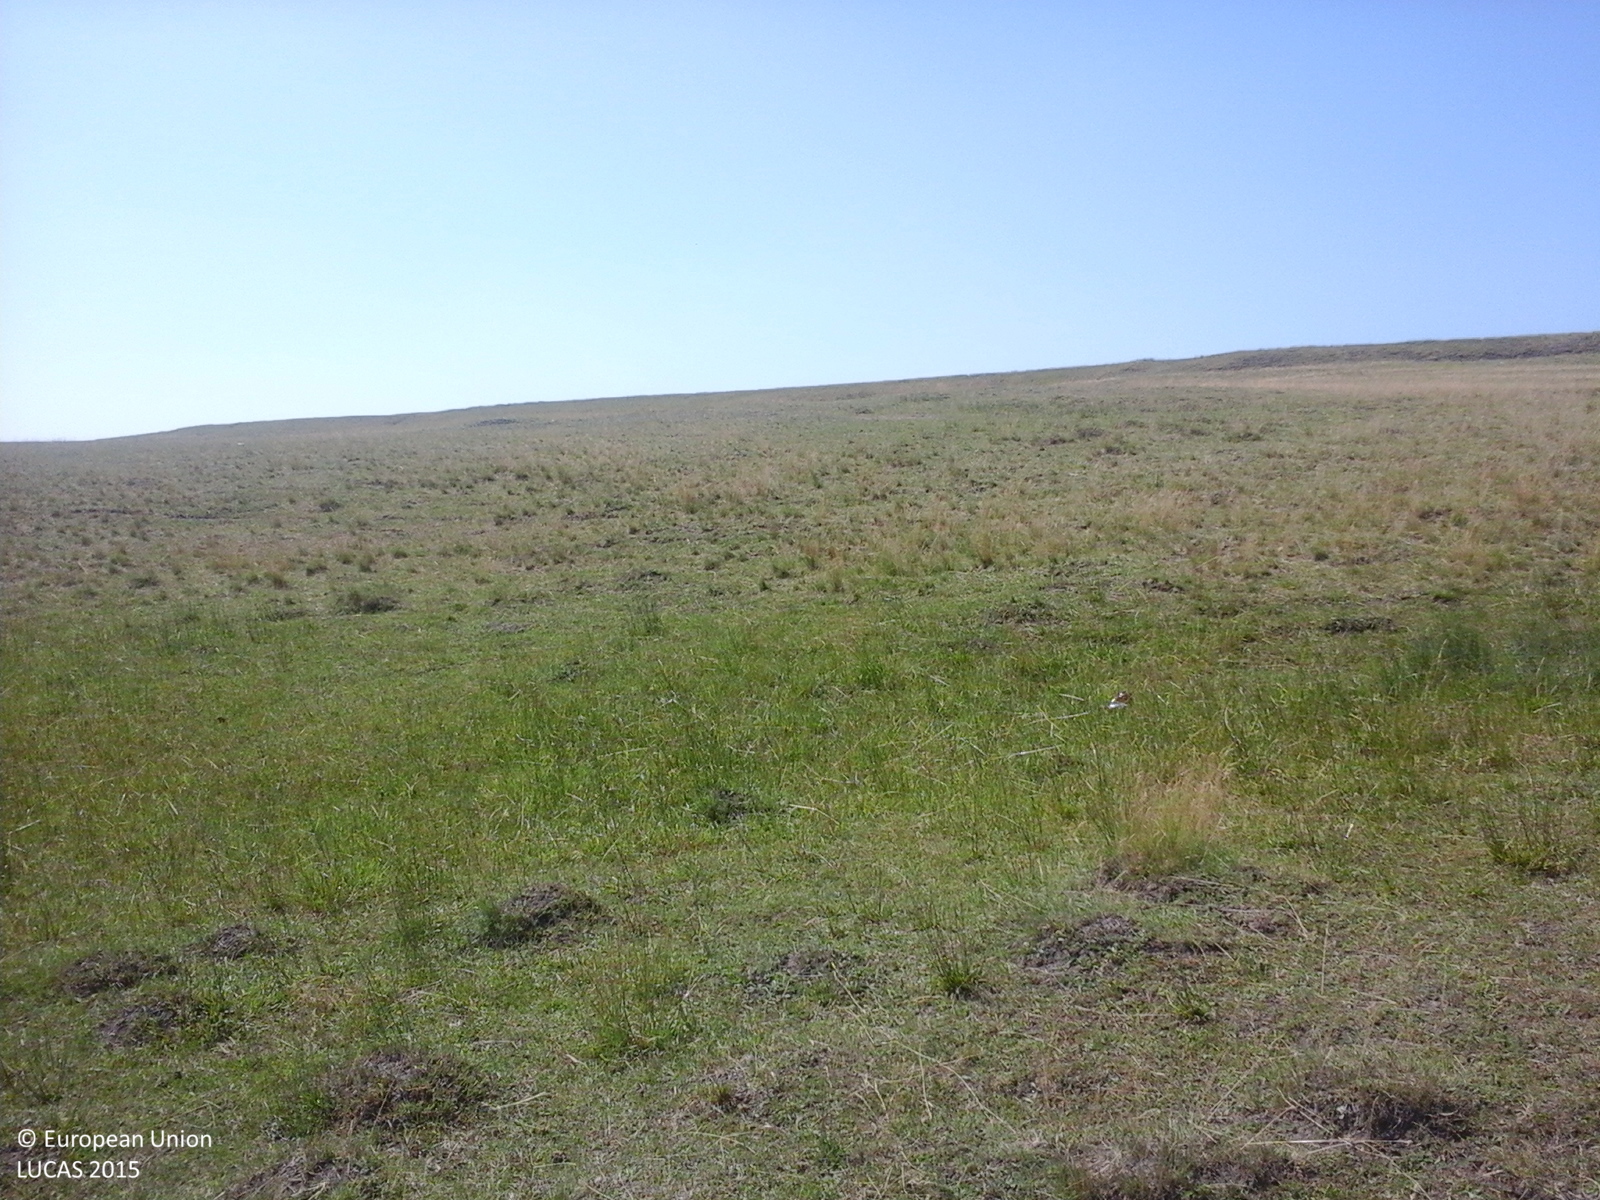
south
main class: Grassland
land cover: Grassland without tree/shrub cover
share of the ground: > 75 %
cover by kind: herbaceous plants 100 %
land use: Agriculture (excluding fallow land and kitchen gardens)
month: June
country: RO
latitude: 47.7153
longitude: 27.1304
